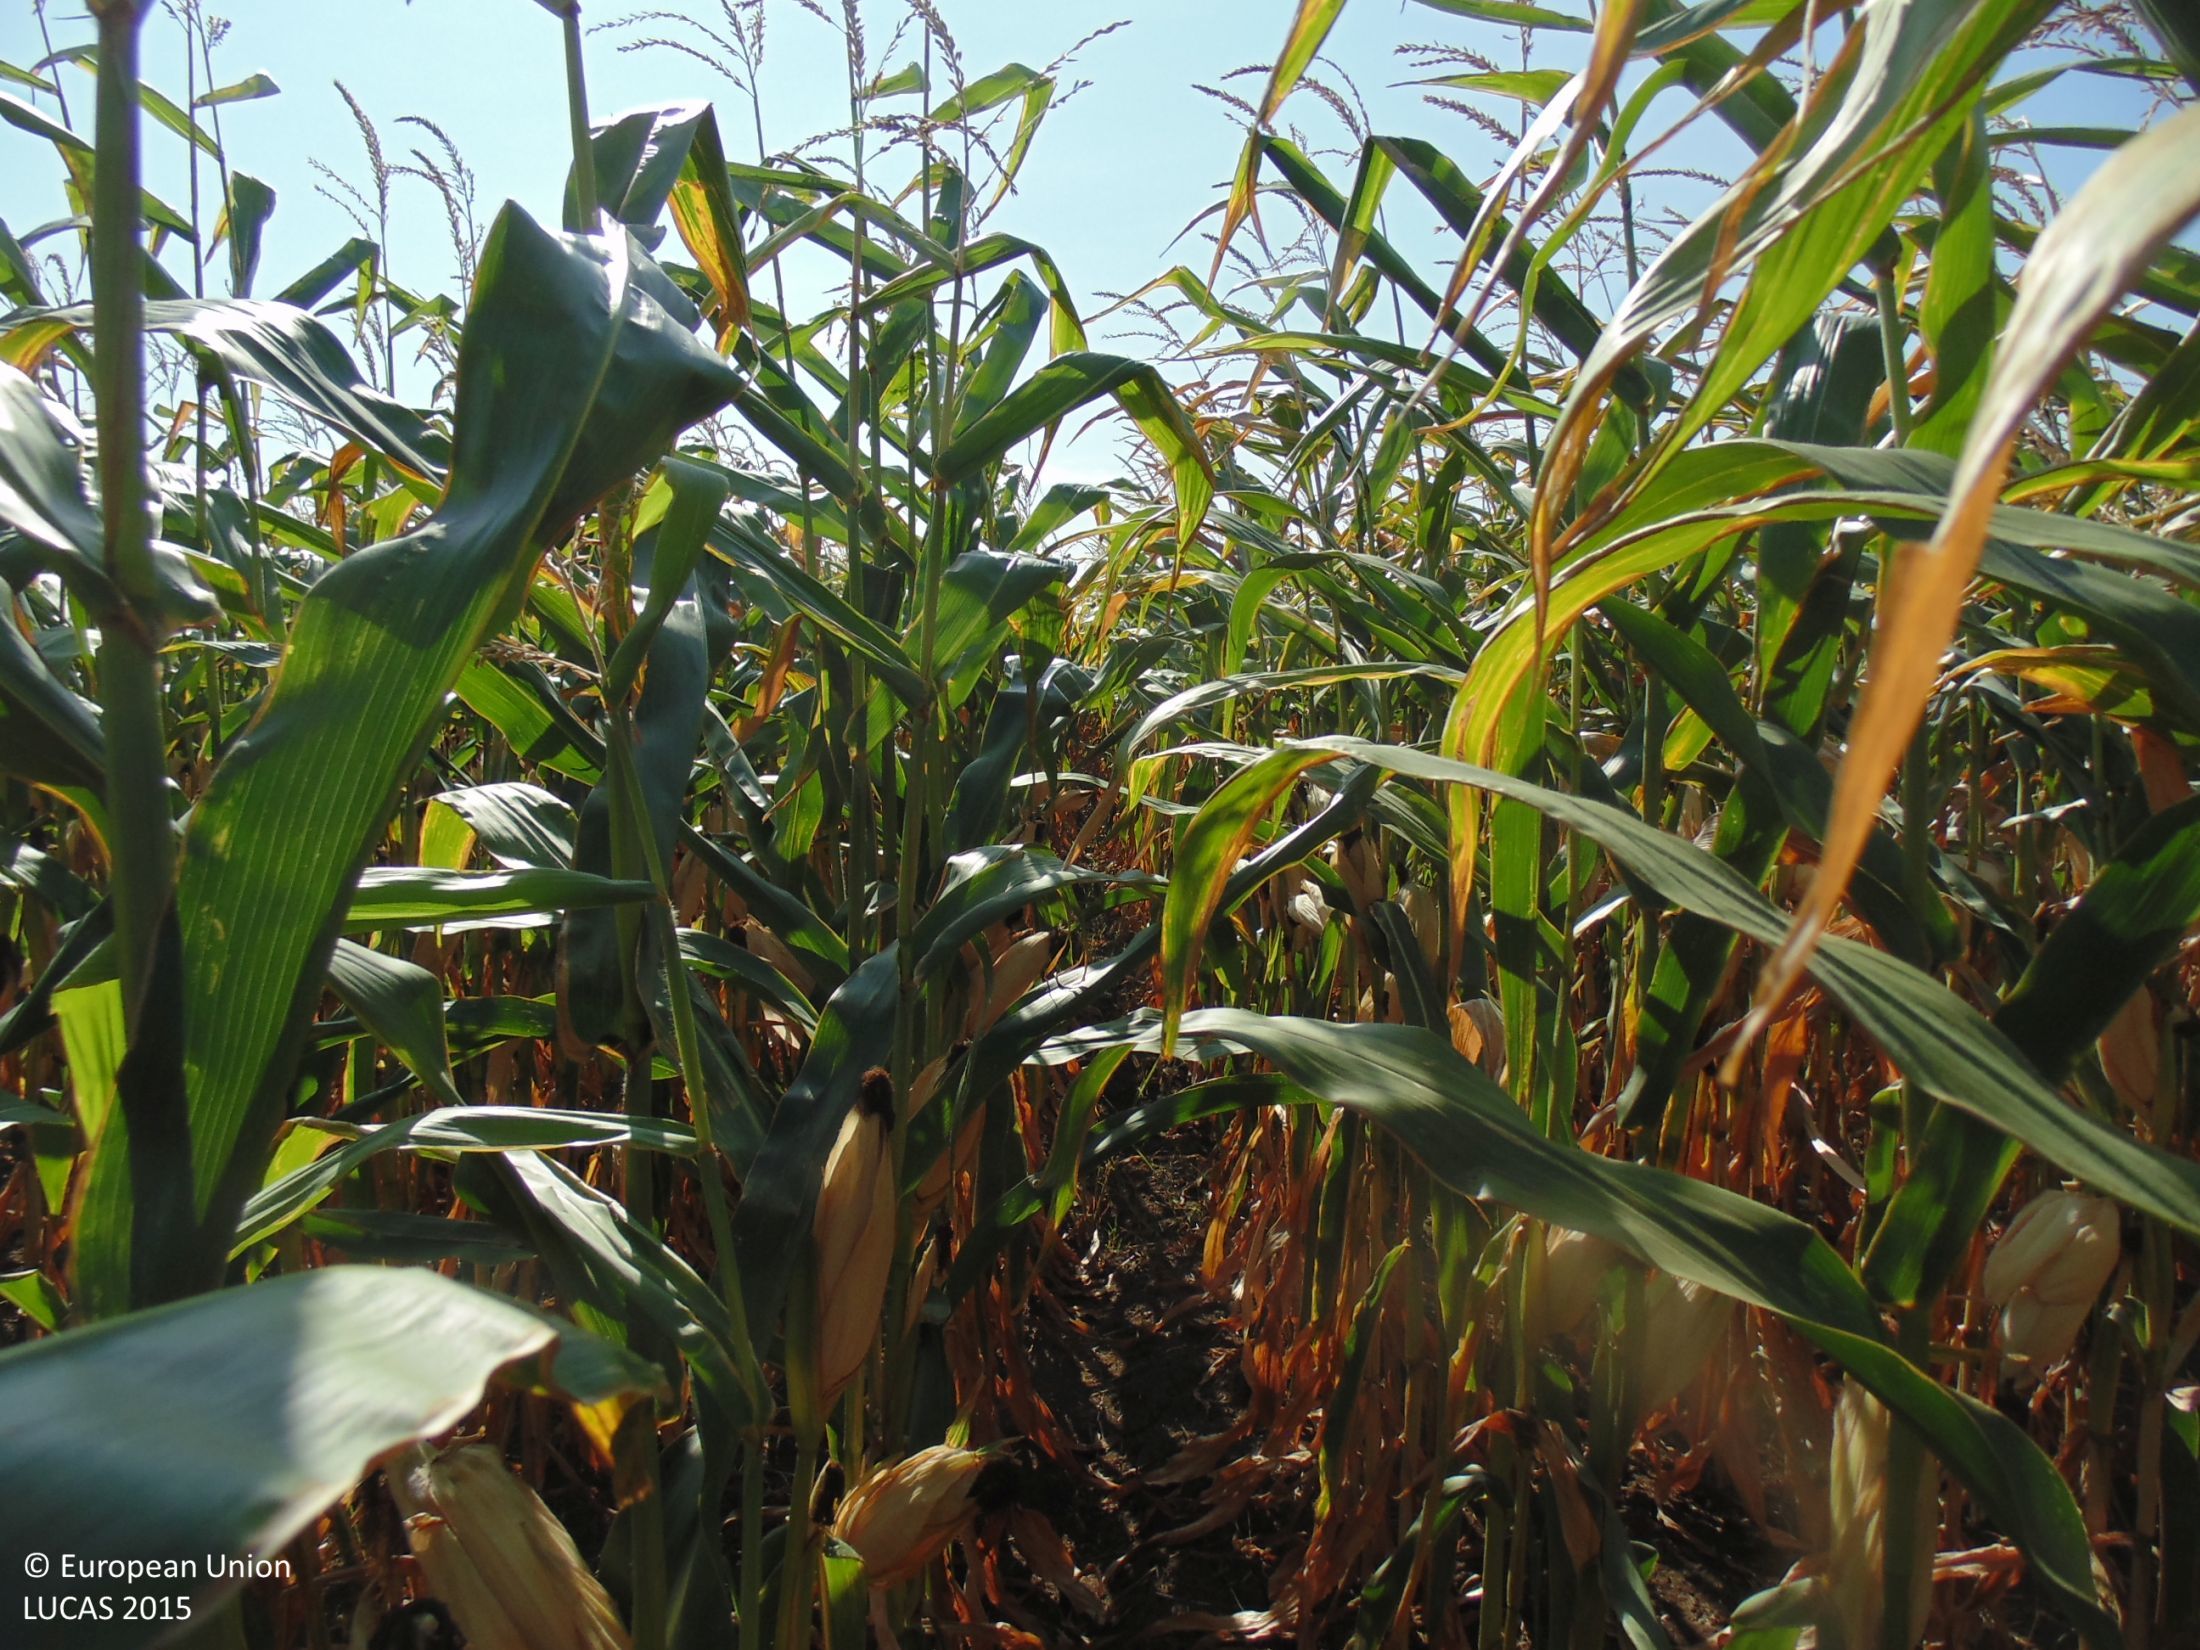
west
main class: Cropland
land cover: Maize
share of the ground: > 75 %
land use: Agriculture (excluding fallow land and kitchen gardens)
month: August
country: BG
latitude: 43.5350
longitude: 28.3090
